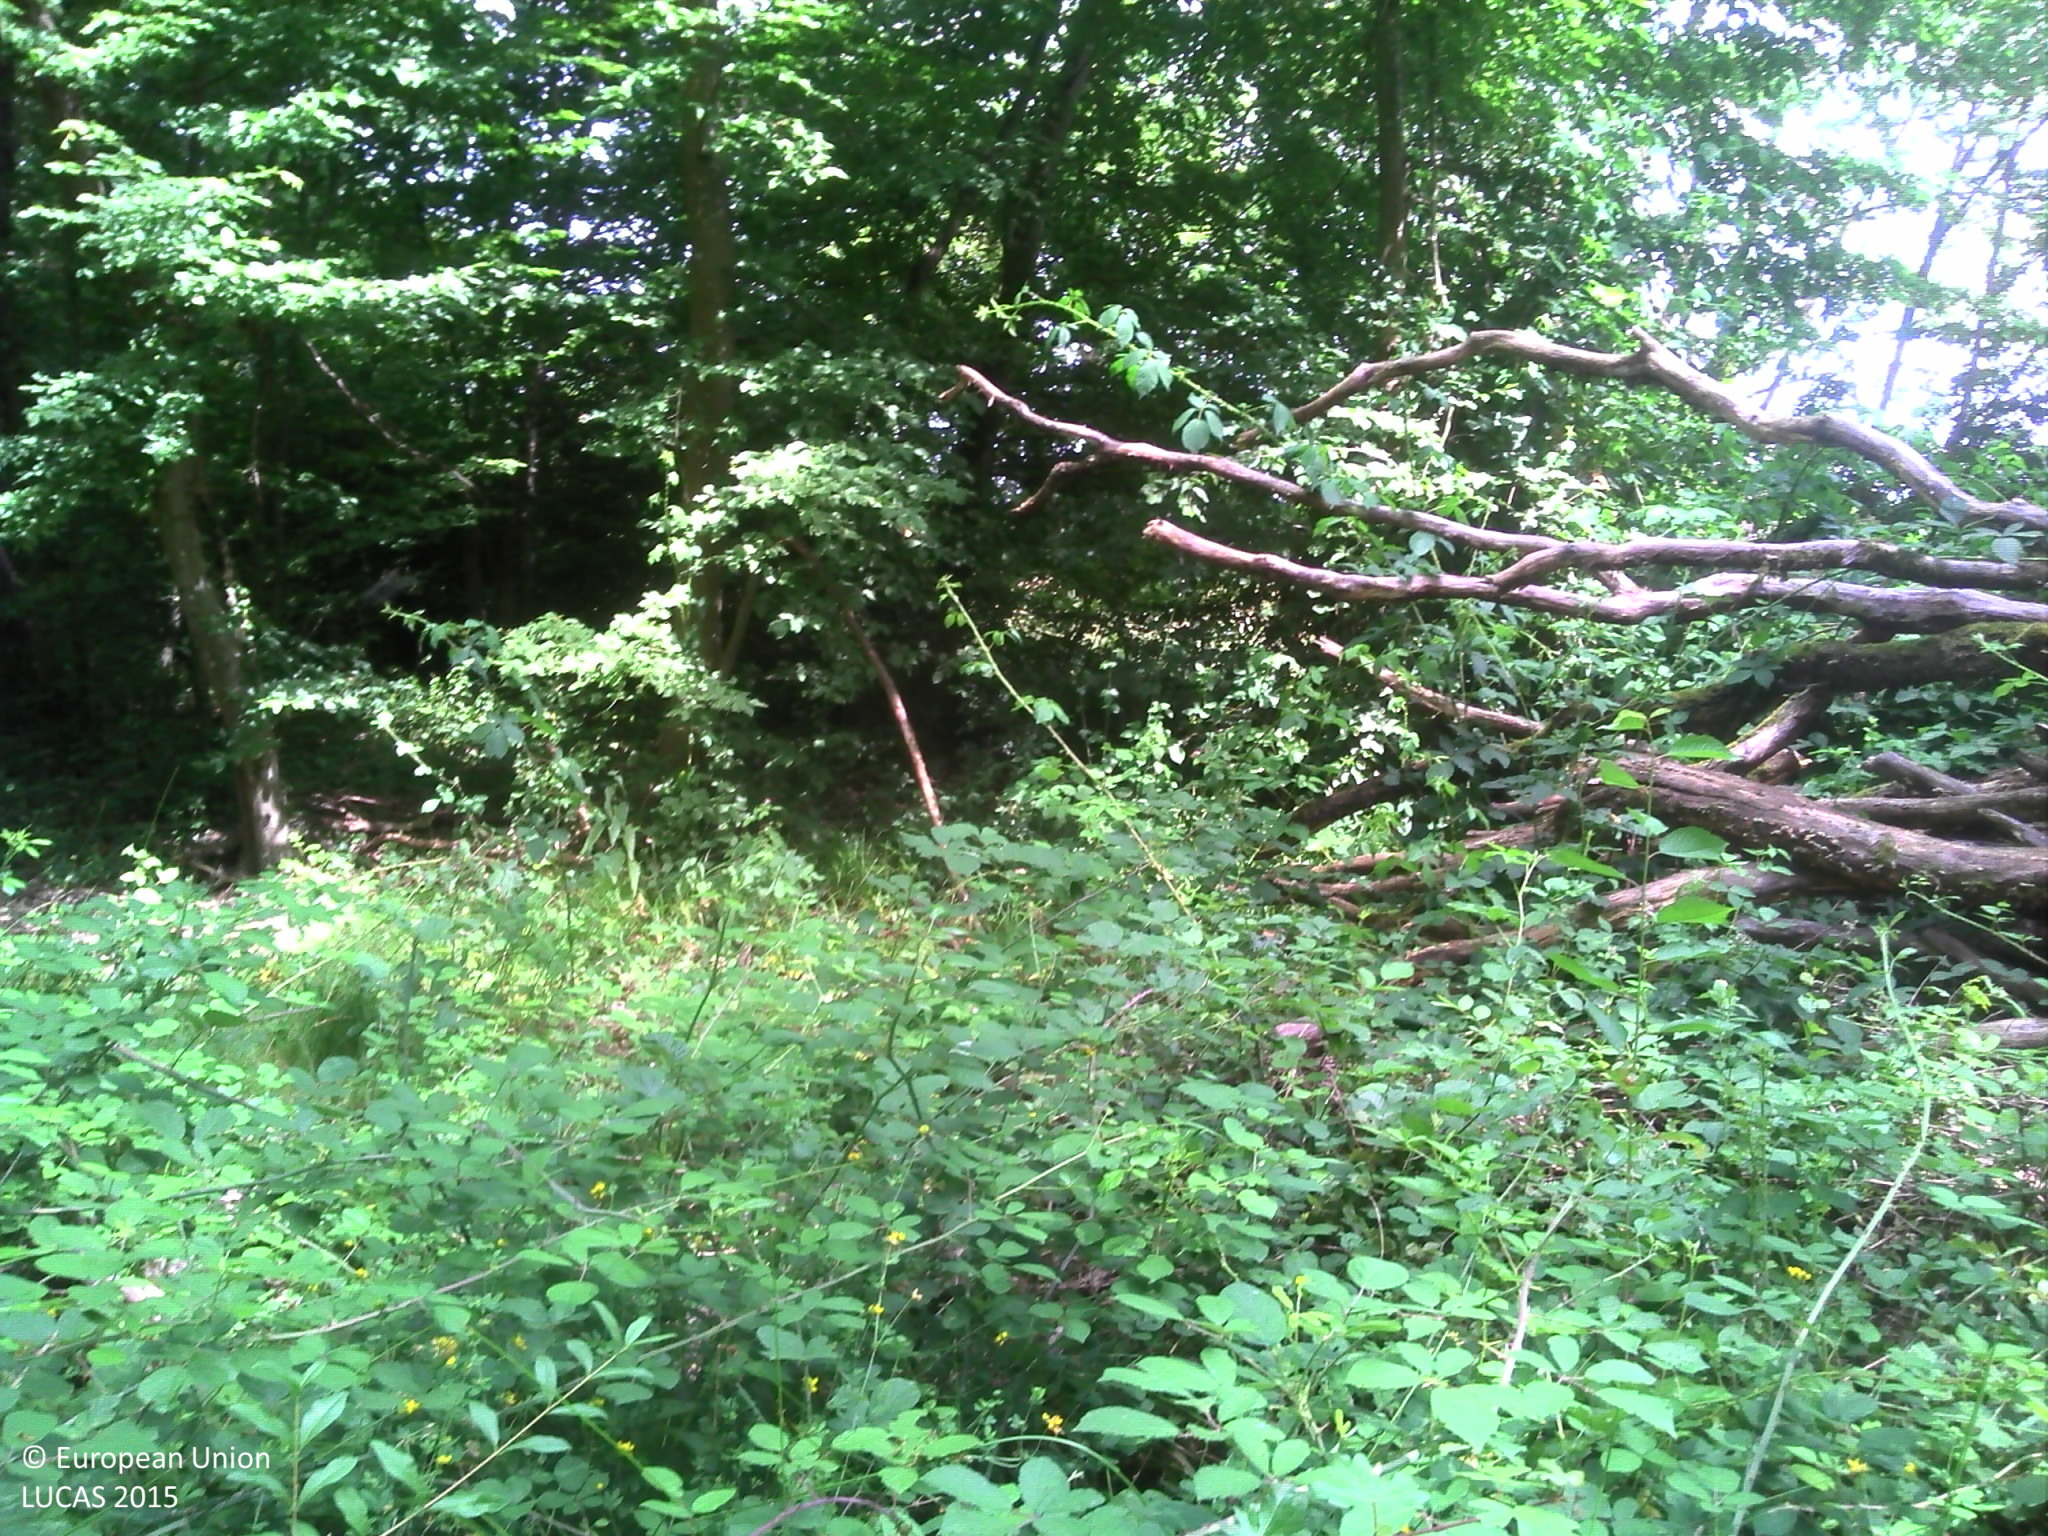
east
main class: Woodland
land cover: Broadleaved woodland
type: mesophytic deciduous forest
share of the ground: > 75 %
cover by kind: broadleaved forest trees 80 %, herbaceous plants 20 %
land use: Forestry
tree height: > 5 m
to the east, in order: Broadleaved woodland; Tracks; Abandoned hedges; Grassland without tree/shrub cover; Fences; Maize
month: June
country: FR
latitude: 46.6765
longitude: 4.8116
